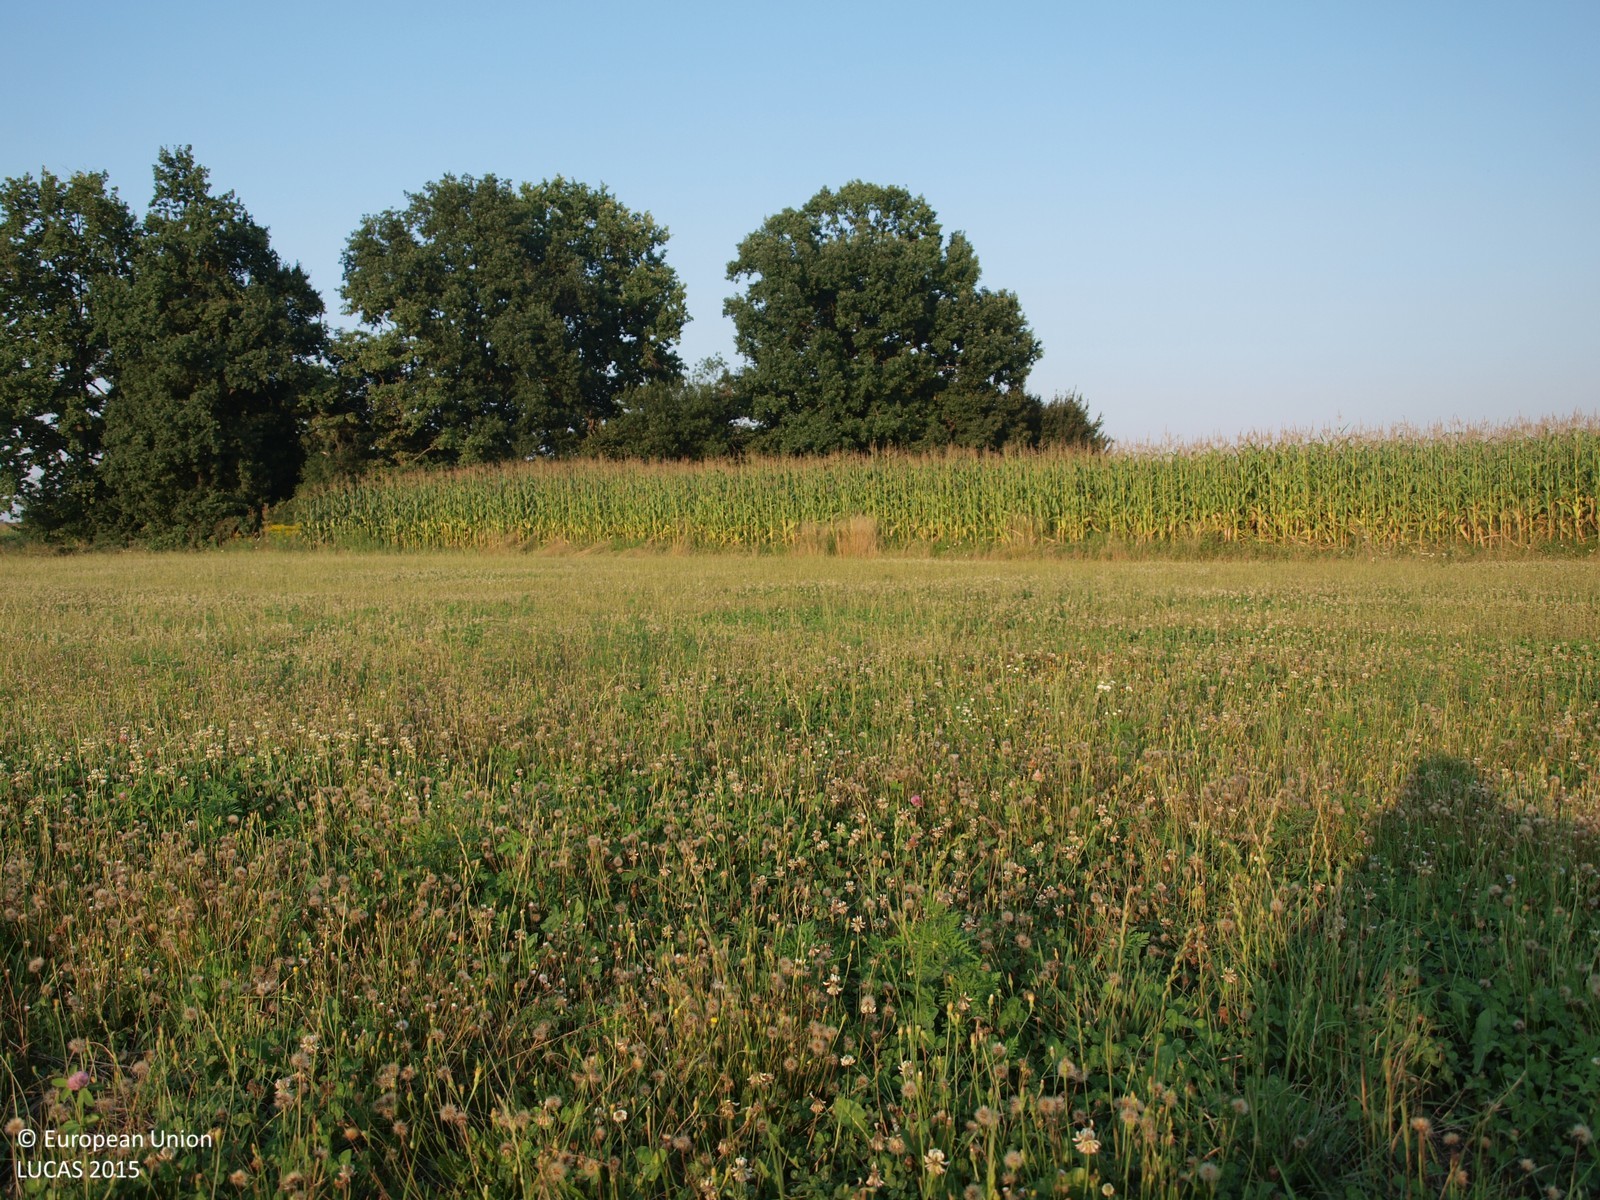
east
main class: Grassland
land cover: Grassland without tree/shrub cover
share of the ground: > 75 %
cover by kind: herbaceous plants 100 %
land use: Agriculture (excluding fallow land and kitchen gardens)
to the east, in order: Grassland without tree/shrub cover; Maize; Abandoned hedges; Ditches and canals; Grassland without tree/shrub cover; Maize; Grass margins; Tracks; Ditches and canals; Grassland without tree/shrub cover
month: August
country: HR
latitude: 45.8282
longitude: 16.4999
